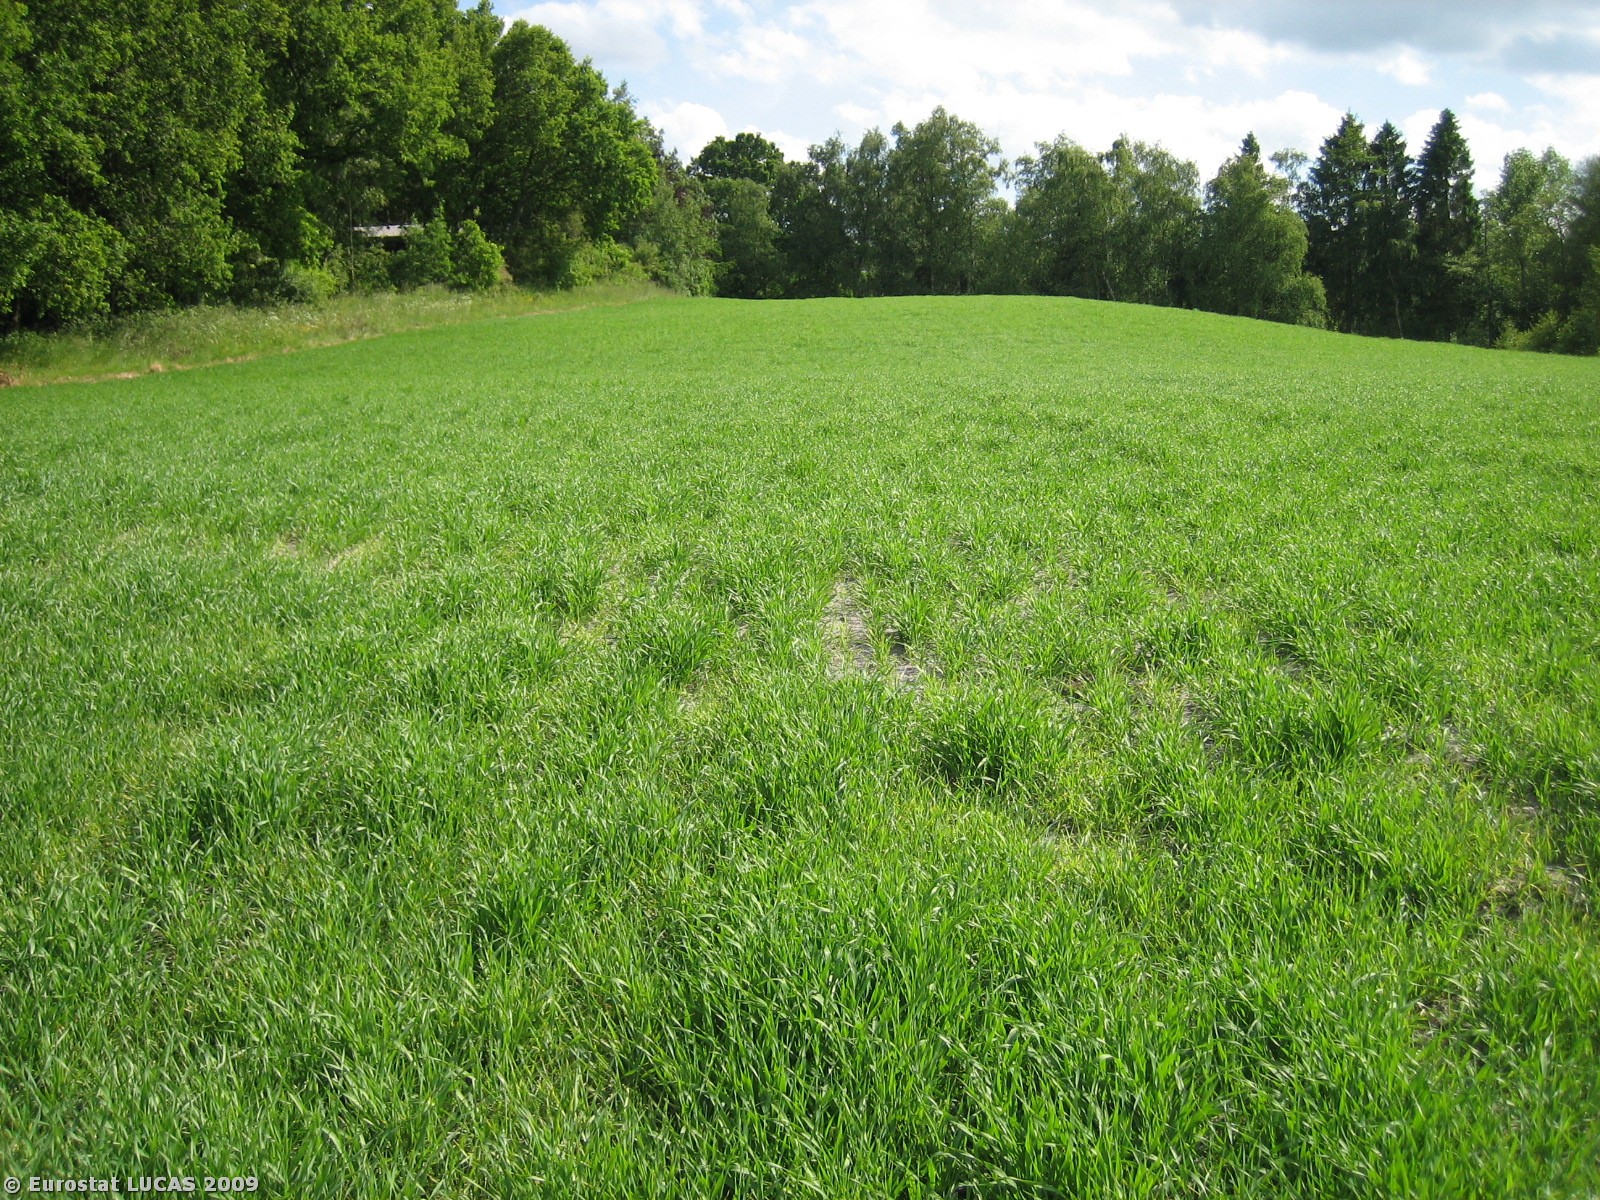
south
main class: Cropland
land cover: Barley
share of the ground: > 75 %
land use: Agriculture (excluding fallow land and kitchen gardens)
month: June
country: DK
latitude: 56.0438
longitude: 9.8557
